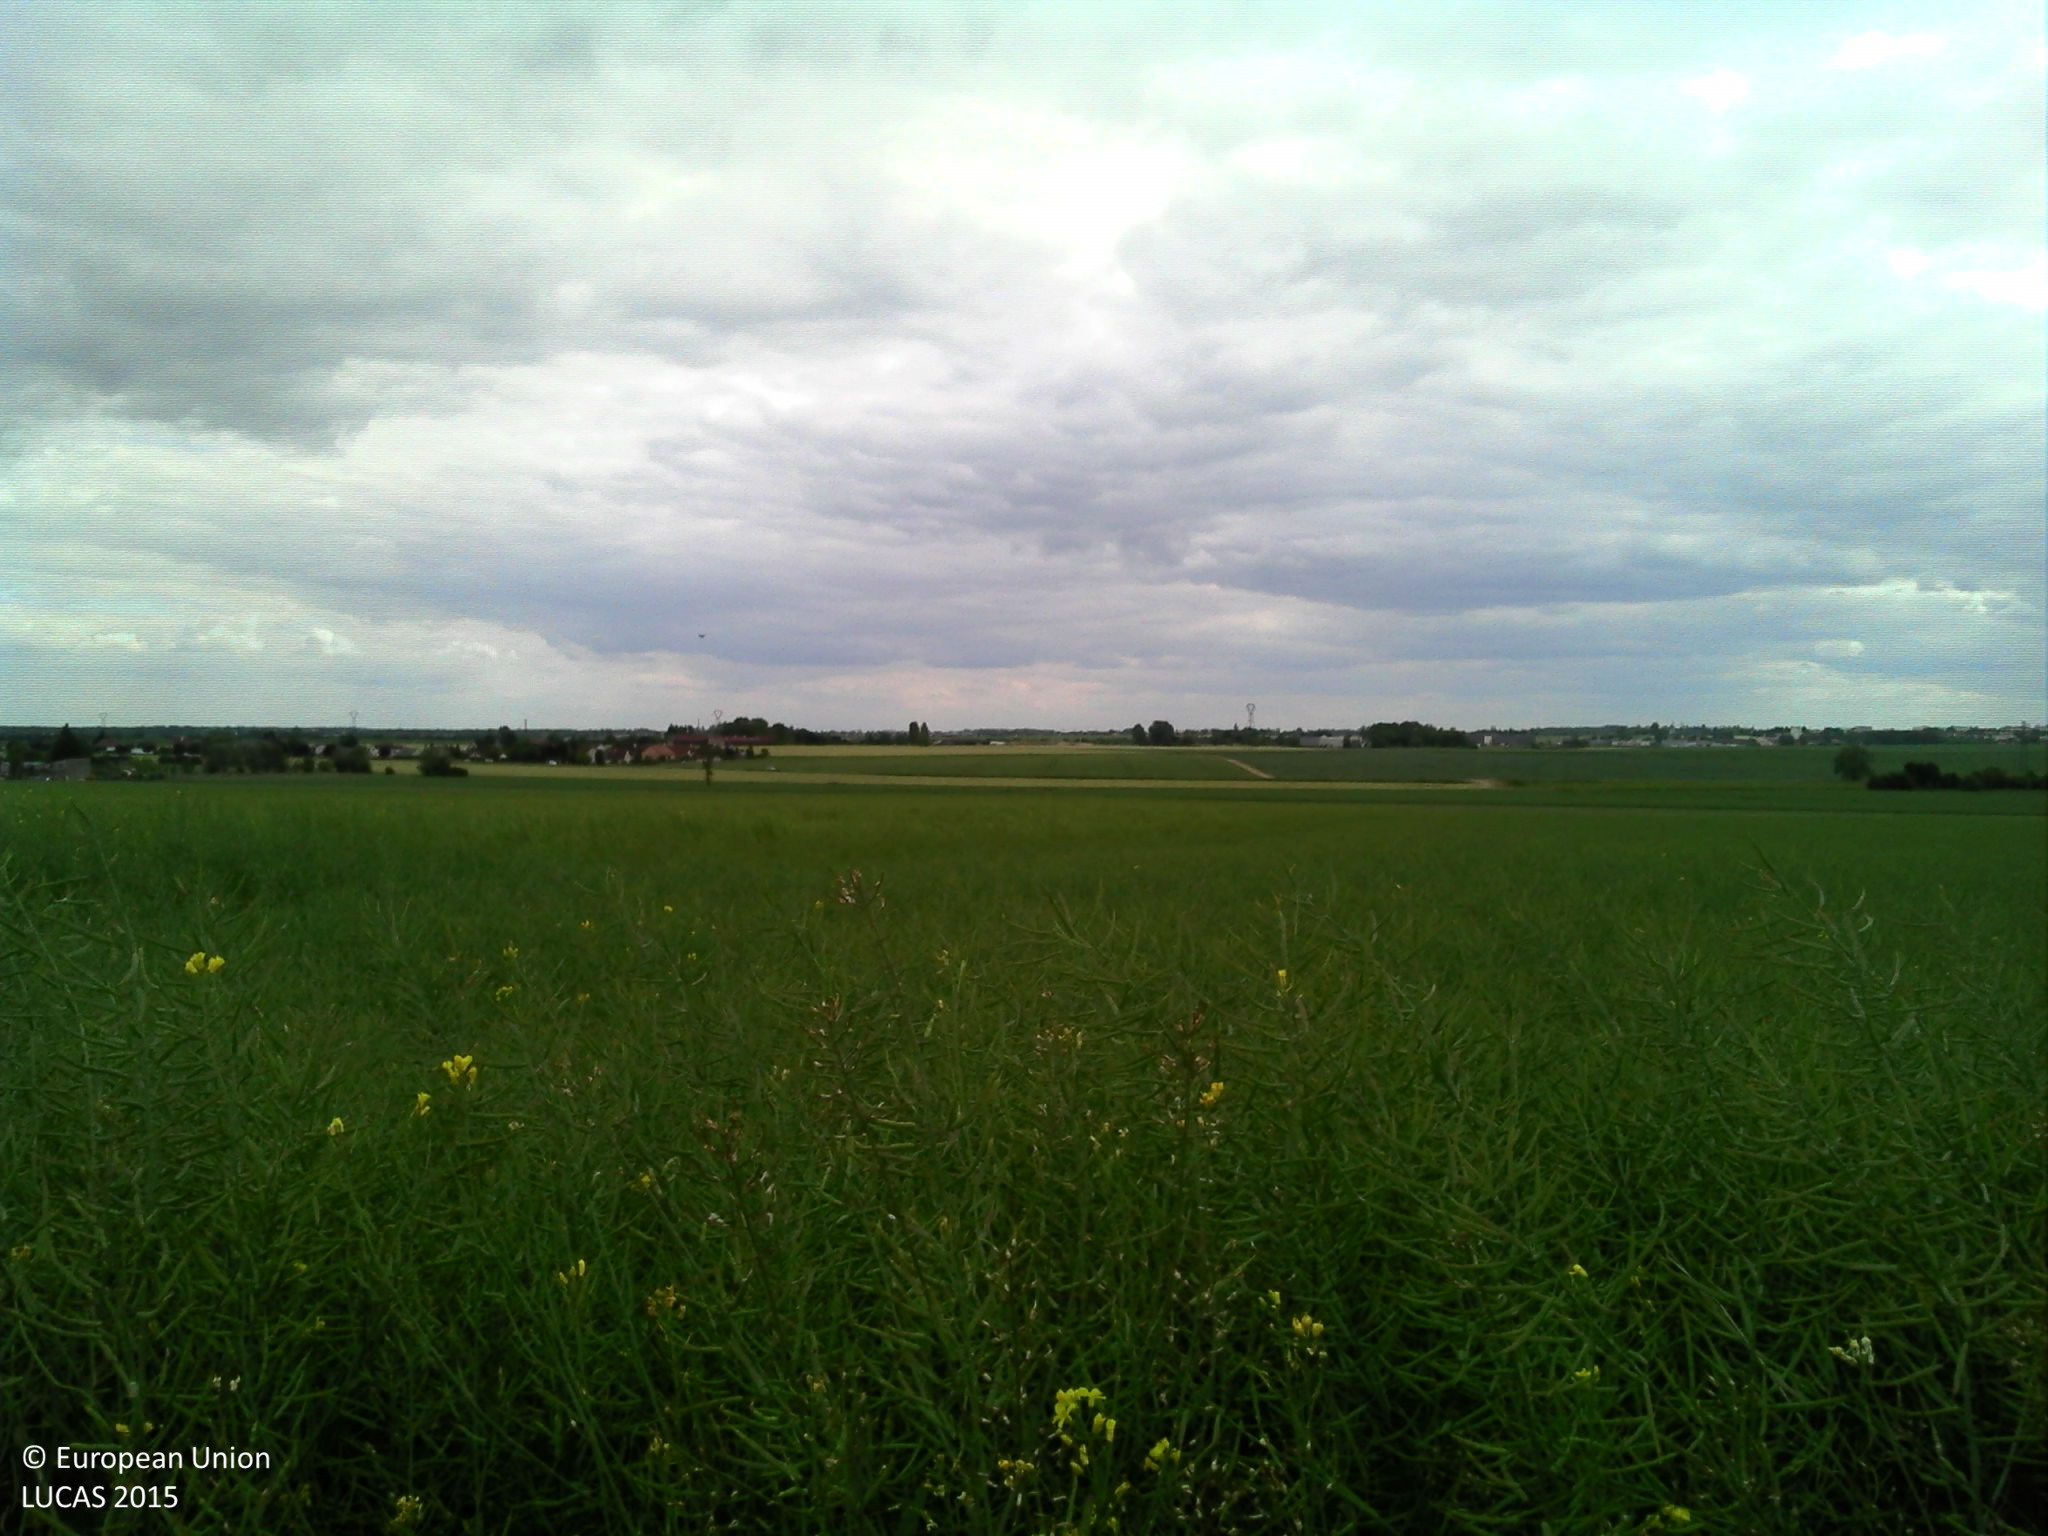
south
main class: Cropland
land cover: Rape and turnip rape
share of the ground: > 75 %
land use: Agriculture (excluding fallow land and kitchen gardens)
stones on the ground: < 10 %
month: May
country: FR
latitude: 47.3580
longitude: 5.1151
